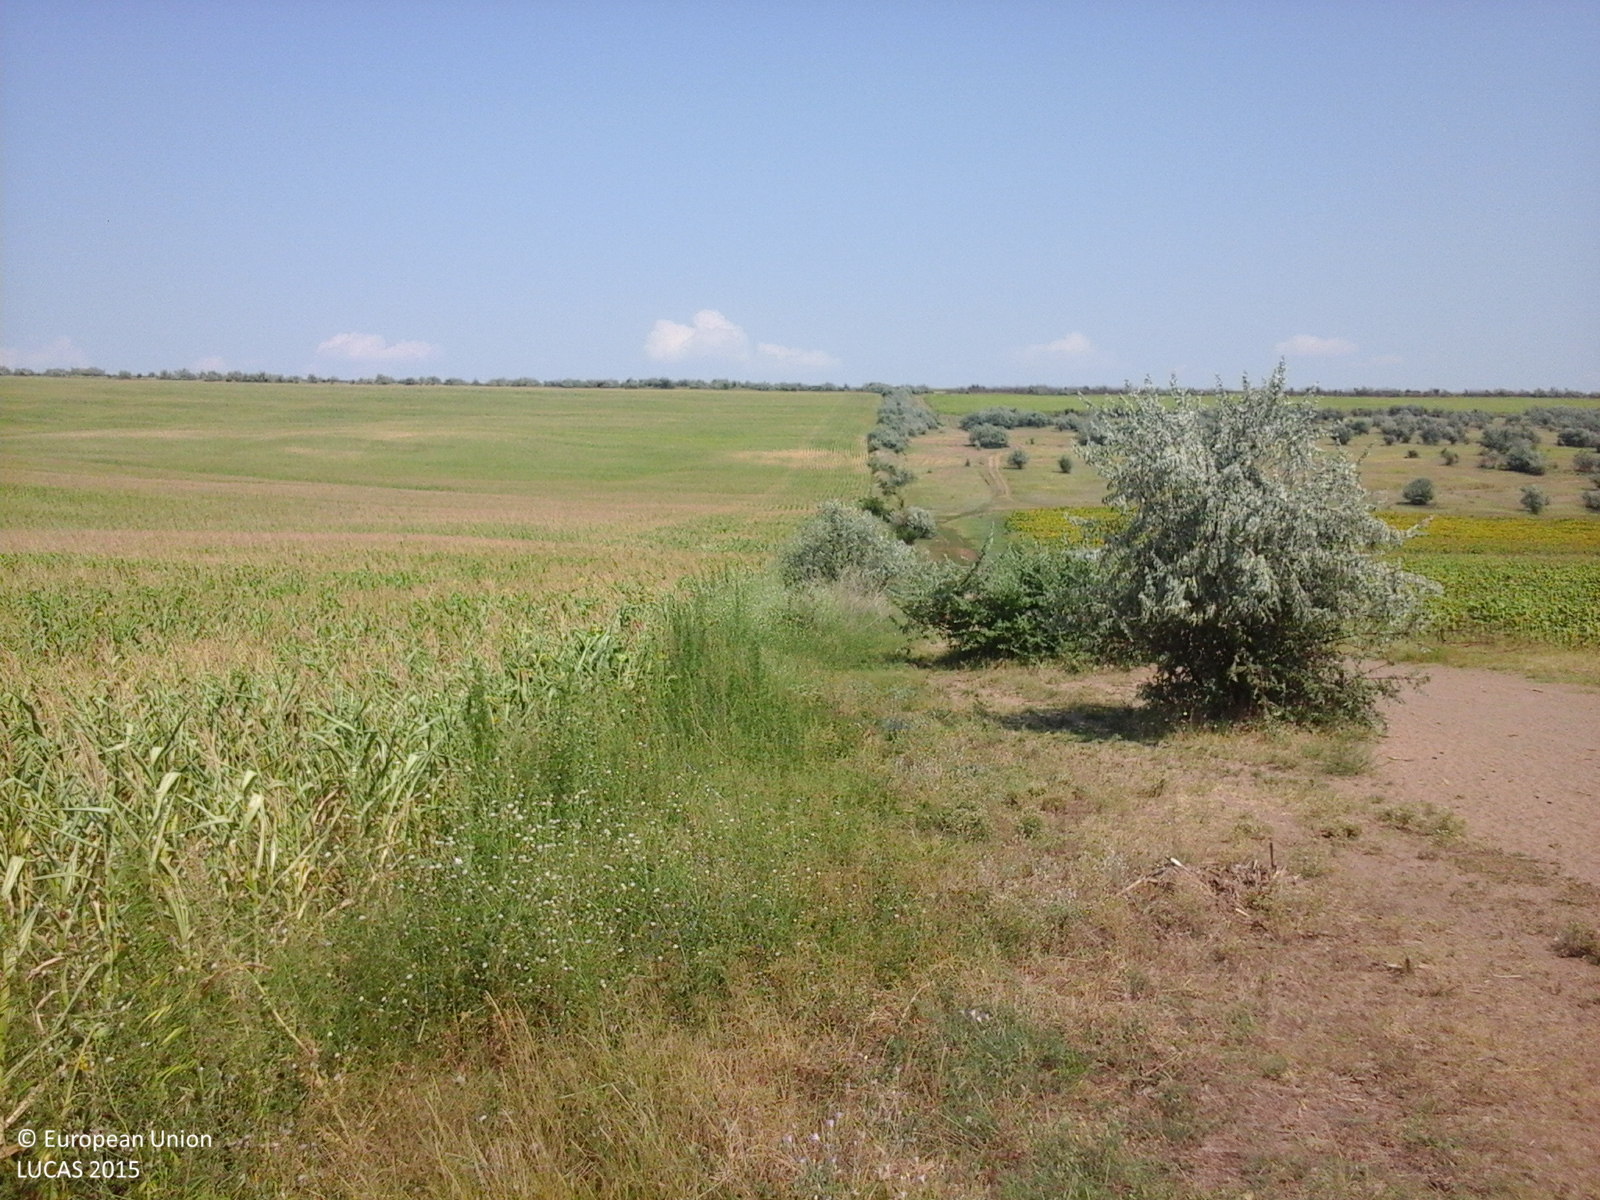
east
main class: Grassland
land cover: Spontaneously vegetated surfaces
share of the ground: > 75 %
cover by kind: herbaceous plants 100 %
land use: Semi-natural and natural areas not in use
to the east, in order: Spontaneously vegetated surfaces; Abandoned hedges; Ditches and canals; Grassland without tree/shrub cover
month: July
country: RO
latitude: 45.9178
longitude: 27.9781
